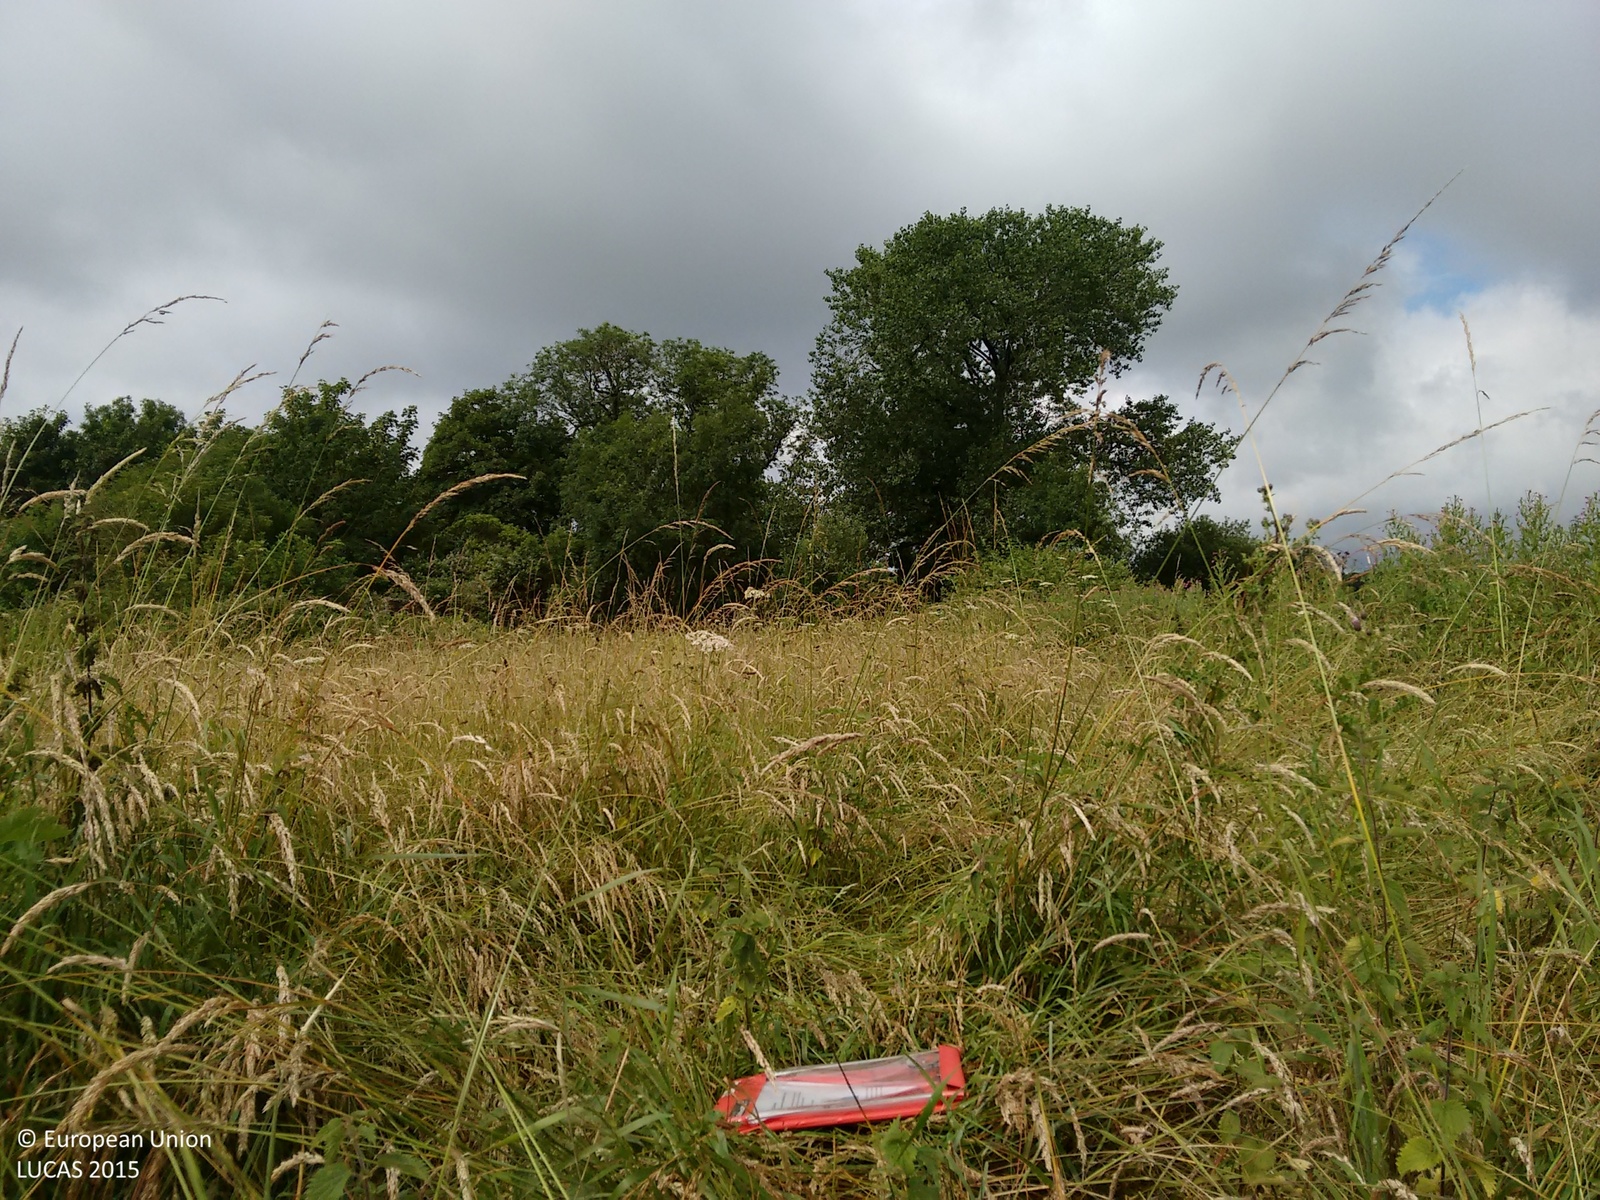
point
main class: Grassland
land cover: Grassland without tree/shrub cover
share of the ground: > 75 %
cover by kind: herbaceous plants 100 %
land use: Abandoned areas
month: July
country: GB
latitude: 51.4939
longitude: -3.6410
